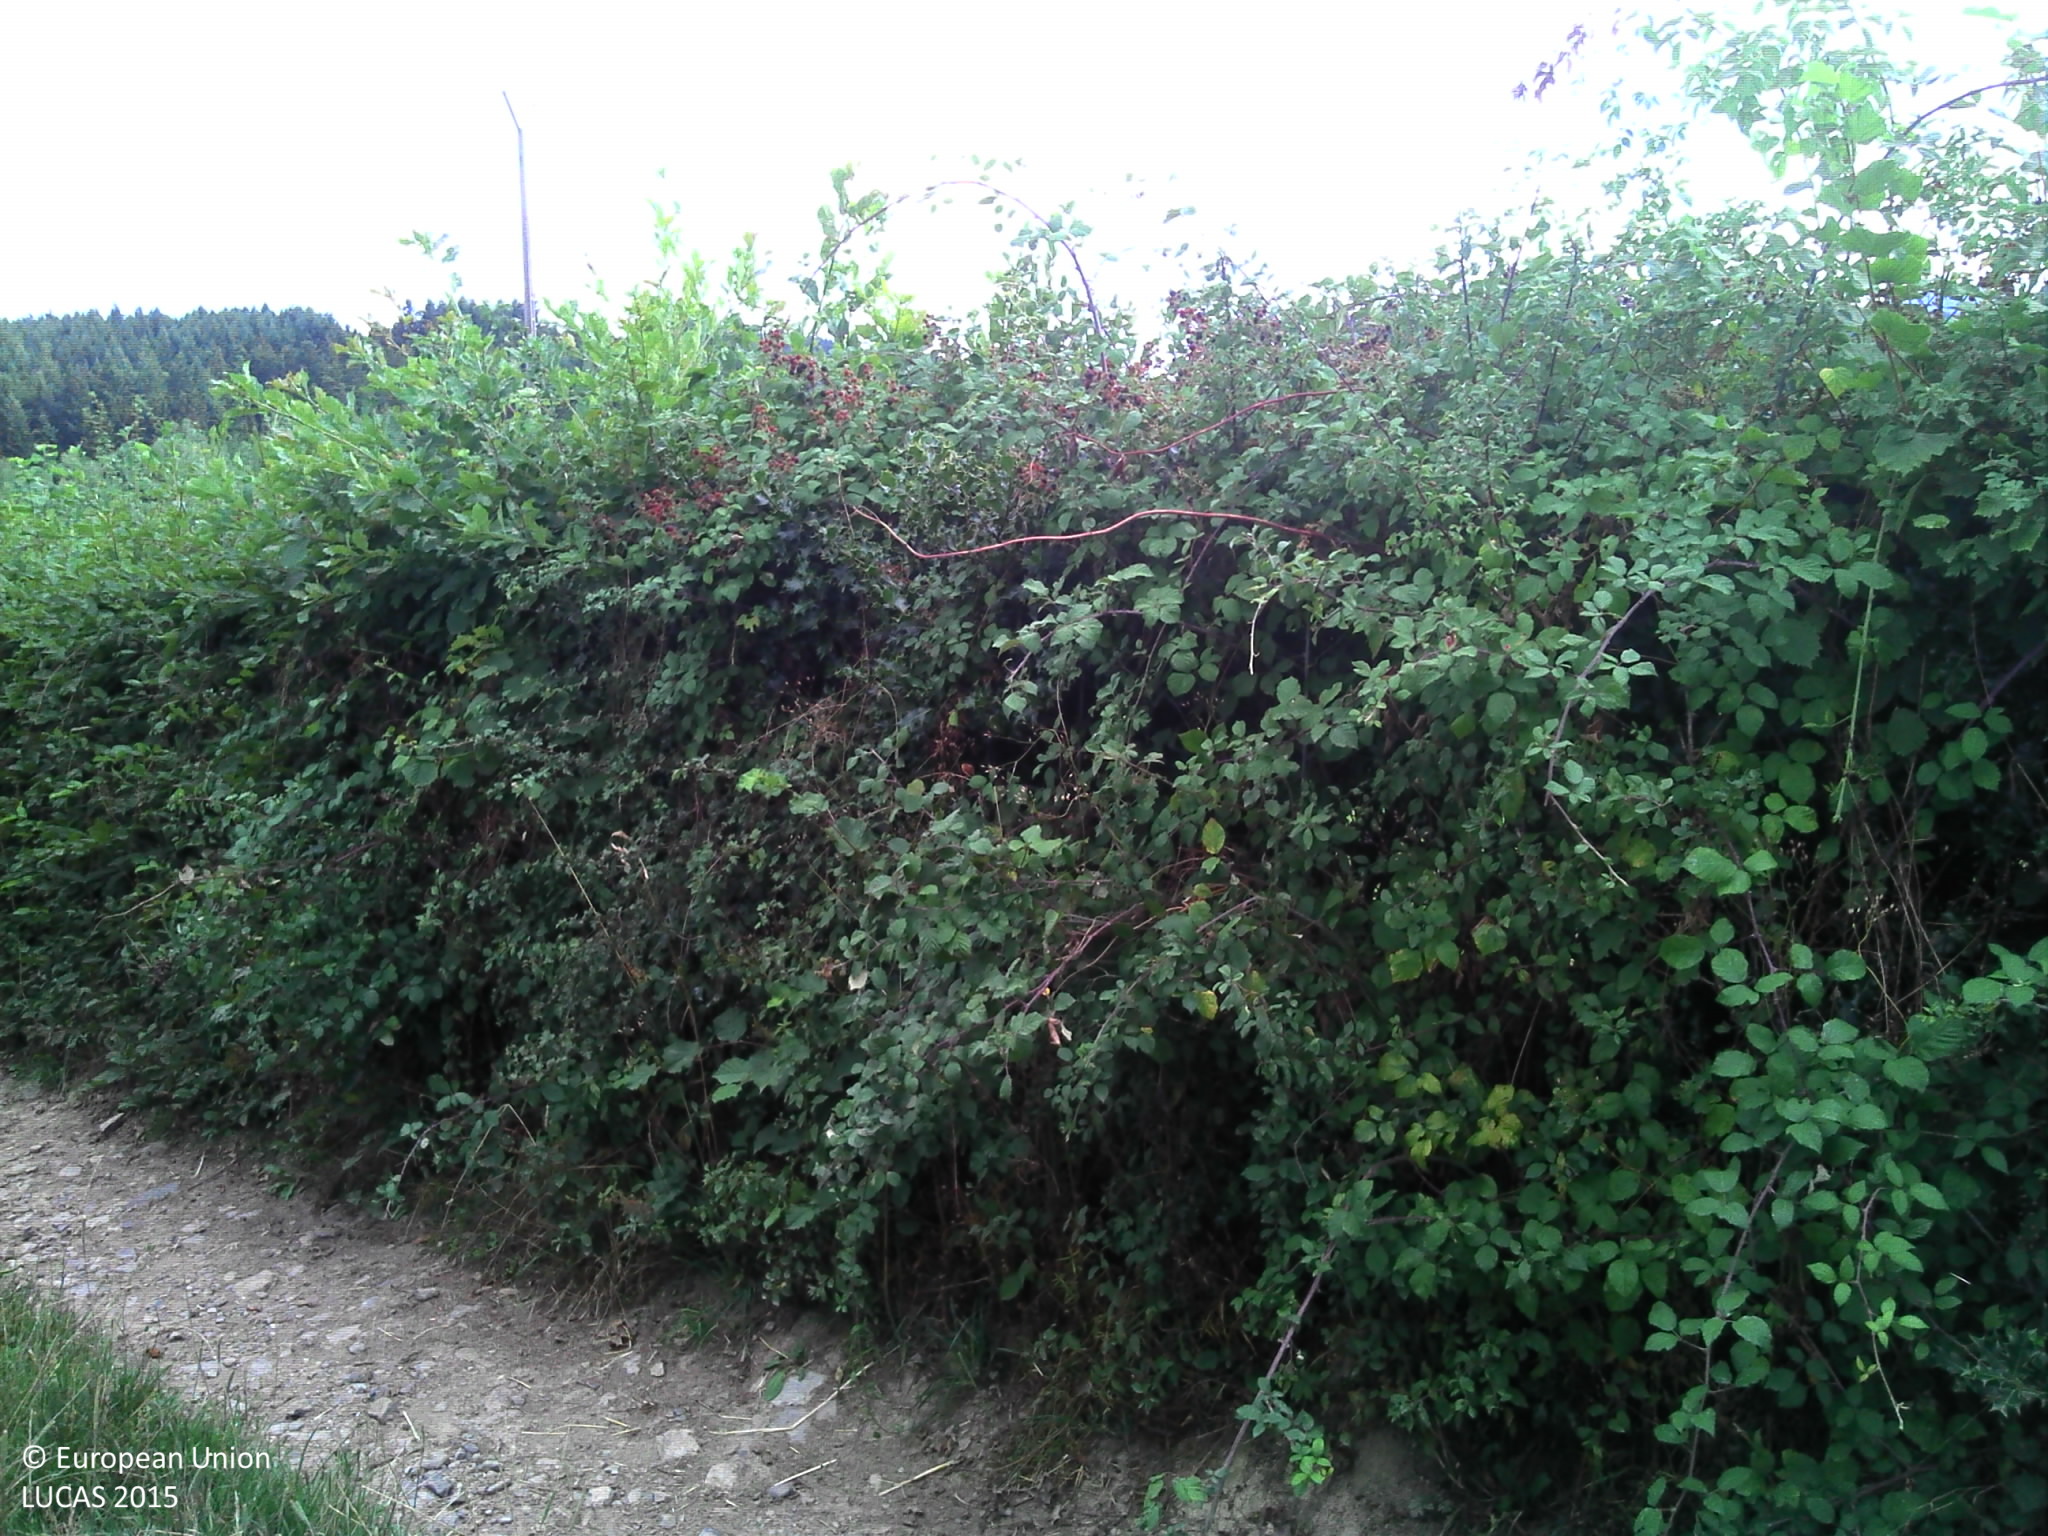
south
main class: Cropland
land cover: Maize
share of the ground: > 75 %
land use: Agriculture (excluding fallow land and kitchen gardens)
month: August
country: FR
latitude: 46.2646
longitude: 4.5137
